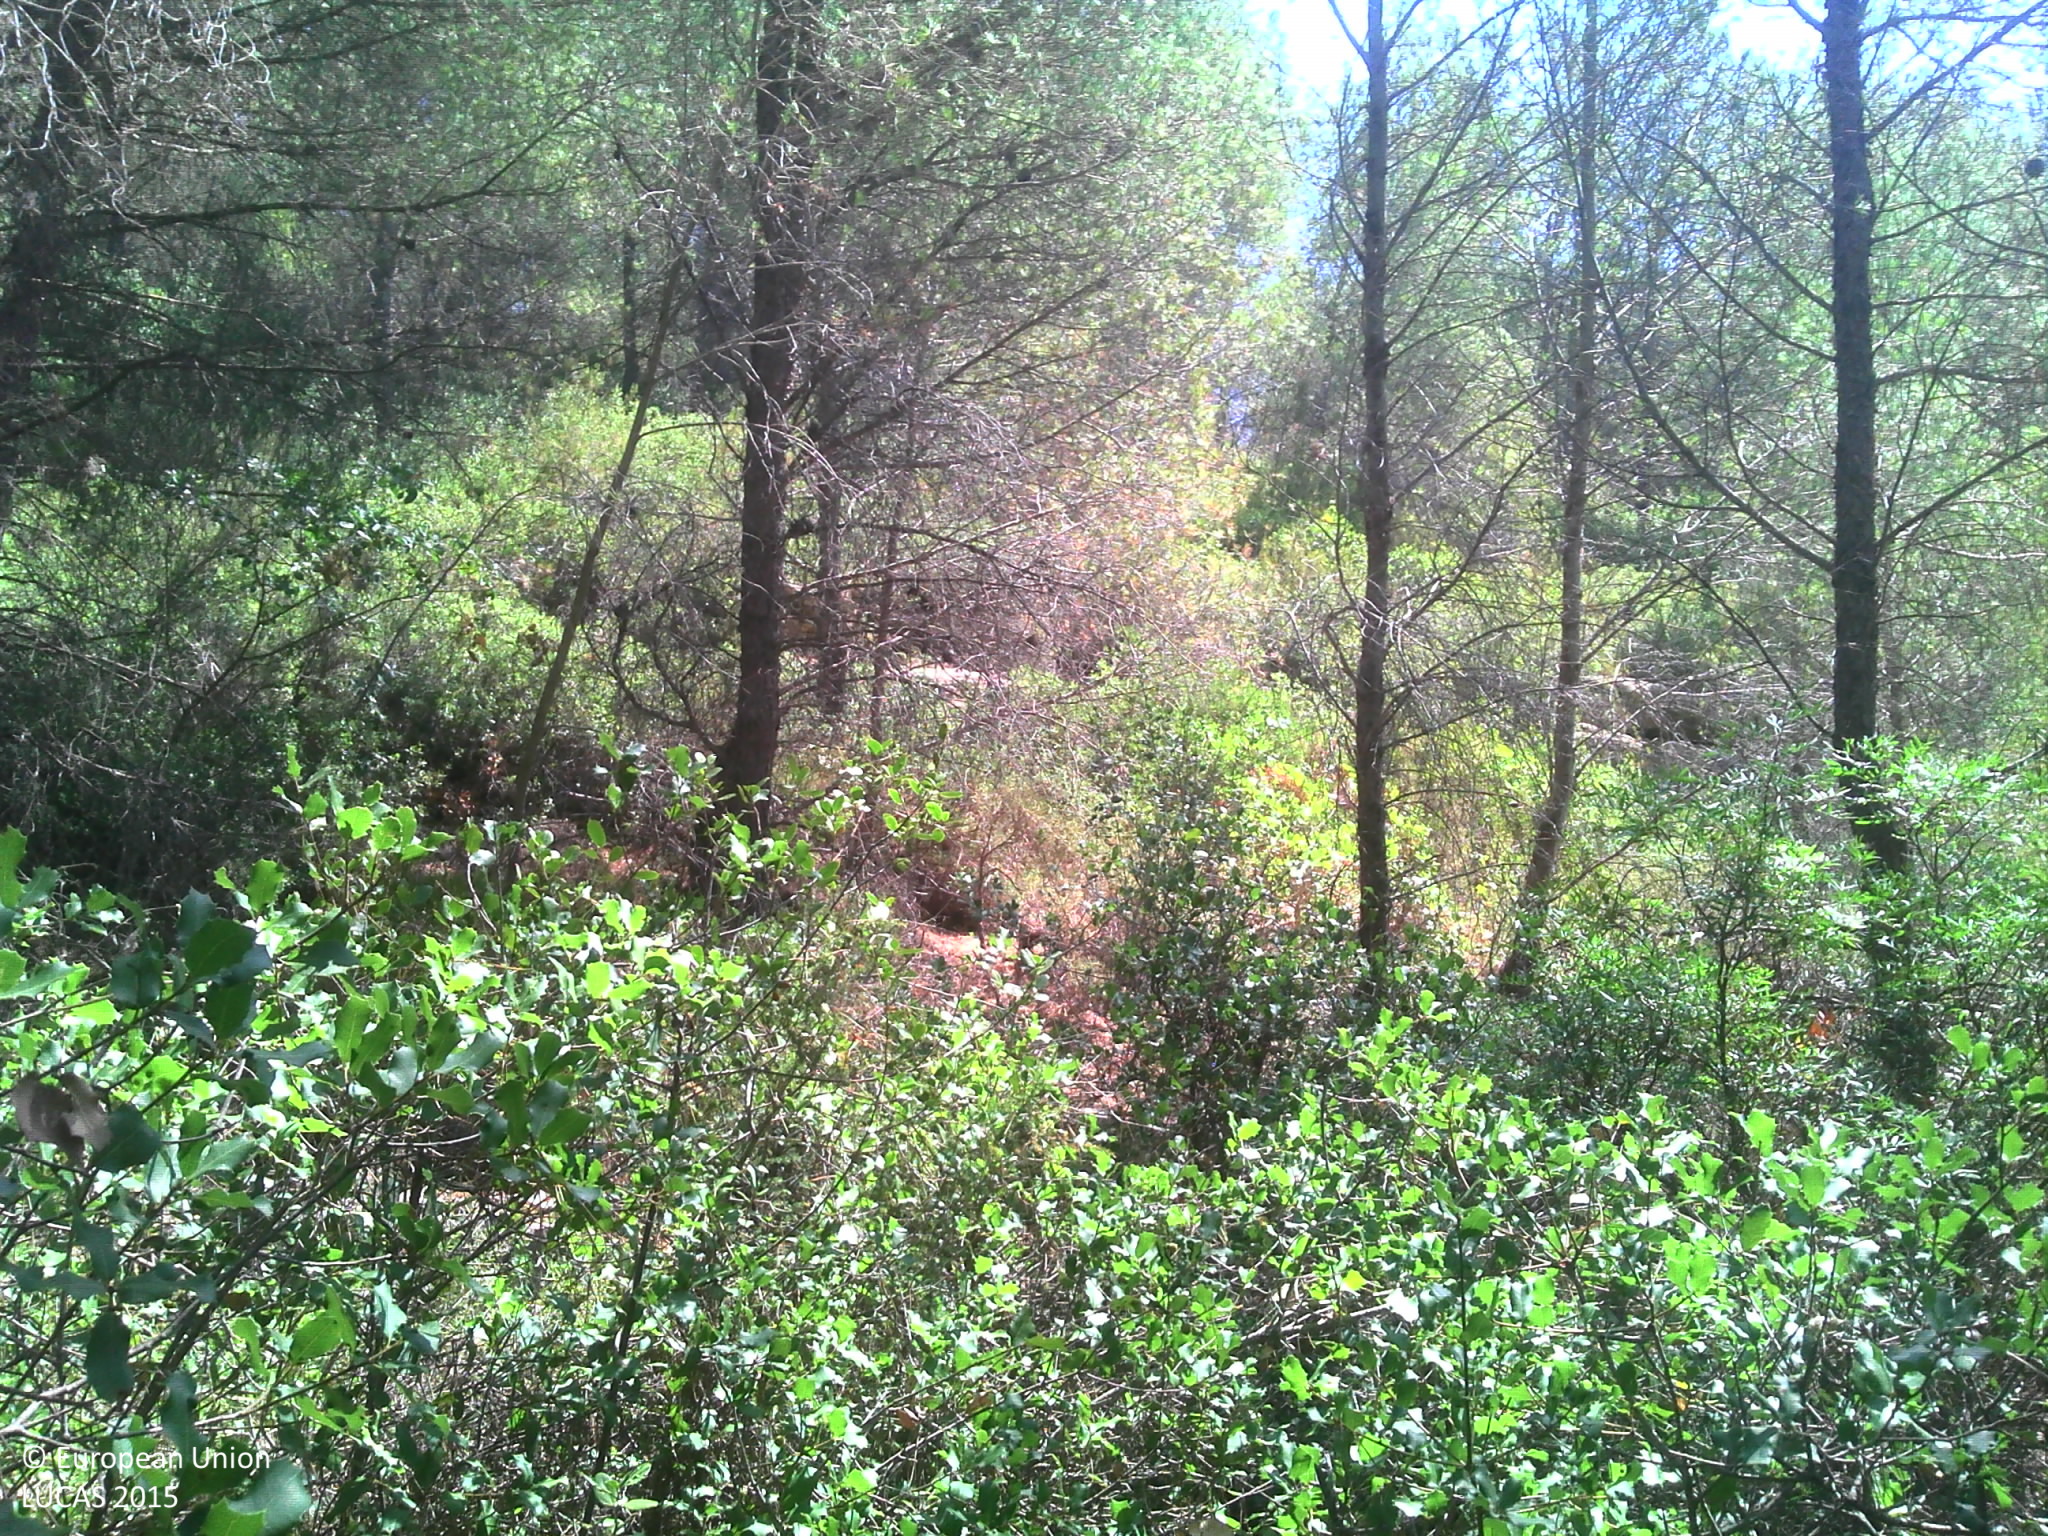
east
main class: Woodland
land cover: Pine dominated coniferous woodland
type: coniferous forest of the mediterranean region
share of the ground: > 75 %
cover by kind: coniferous forest trees 80 %, broadleaved forest trees 20 %
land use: Forestry
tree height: < 5 m
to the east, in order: Pine dominated coniferous woodland; Tracks; Shrubland without tree cover; Pine dominated coniferous woodland; Shrubland without tree cover; Tracks; Pine dominated coniferous woodland; Artificial constructions in urban areas; Shrubland with sparse tree cover; Dry stone walls; Shrubland with sparse tree cover
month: August
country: FR
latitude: 43.2090
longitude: 5.5917
